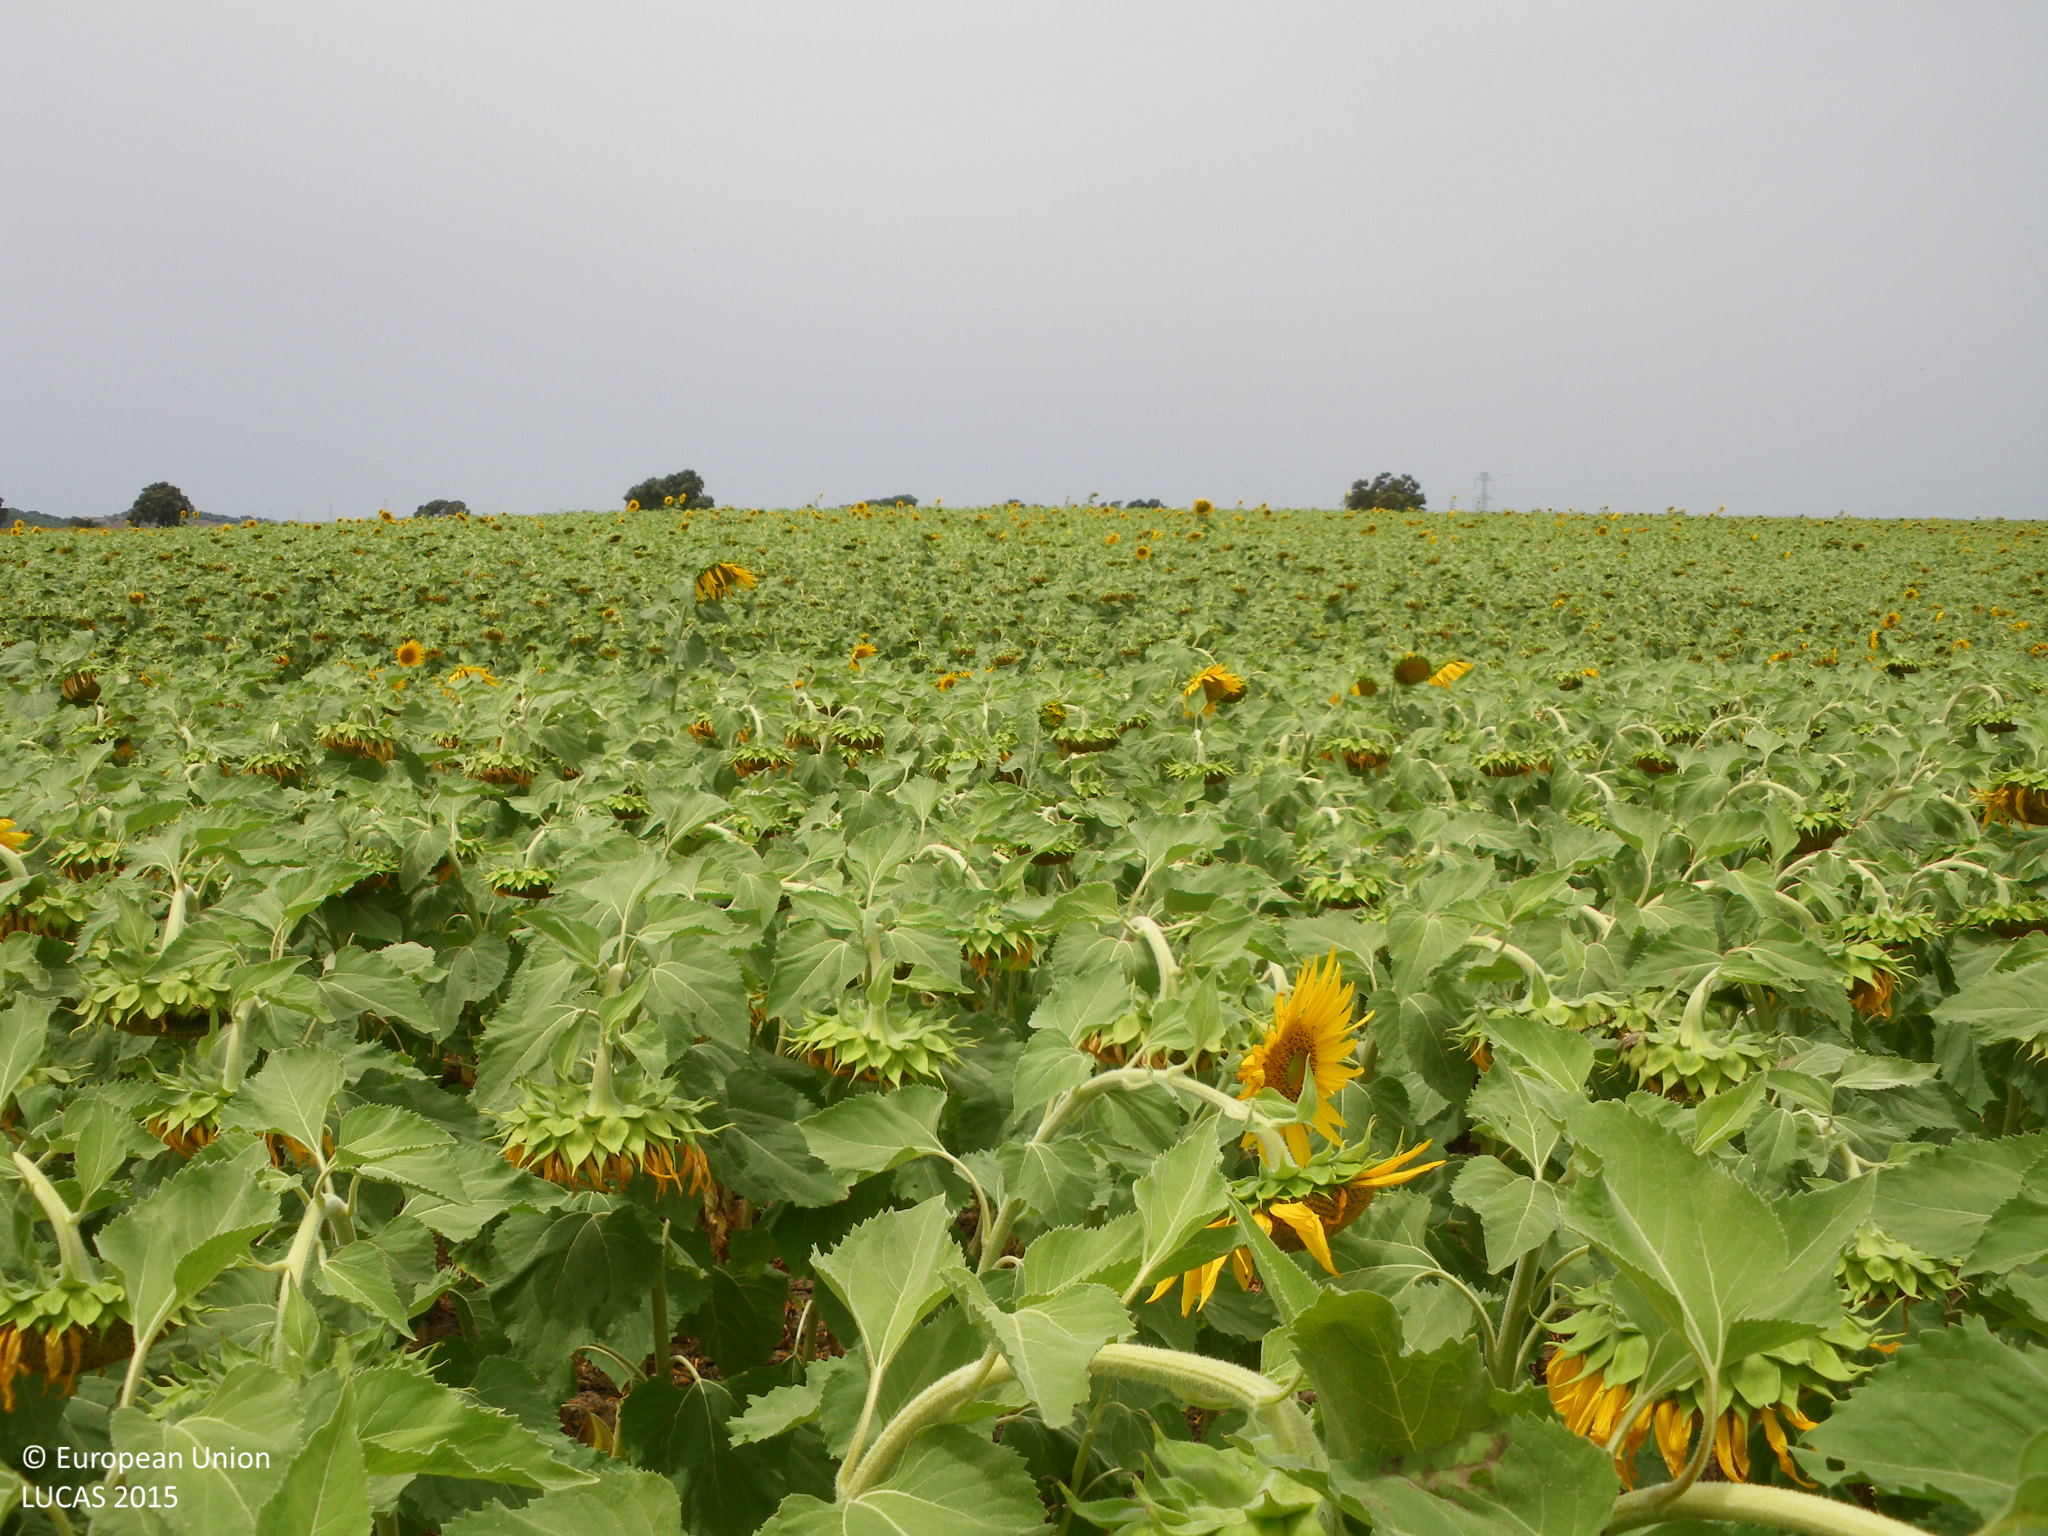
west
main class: Cropland
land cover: Sunflower
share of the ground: > 75 %
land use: Agriculture (excluding fallow land and kitchen gardens)
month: June
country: ES
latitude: 36.6288
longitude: -5.9664
